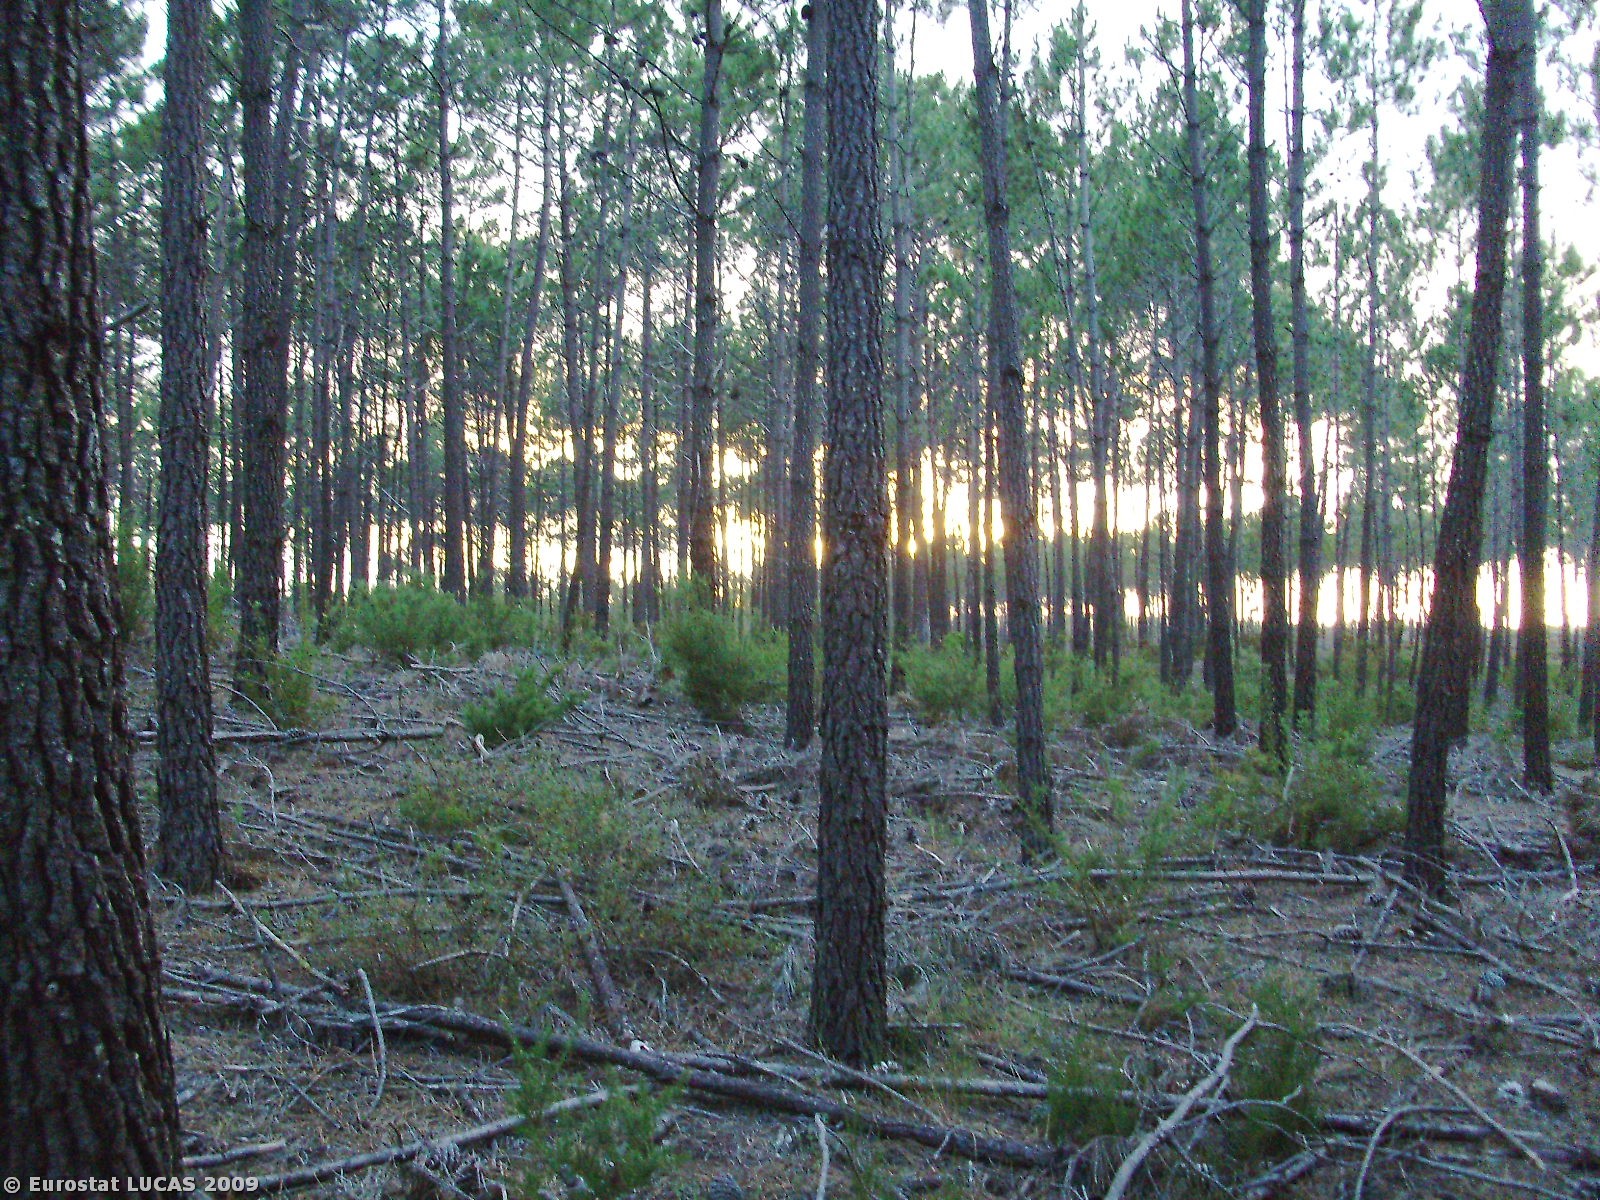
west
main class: Woodland
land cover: Coniferous woodland
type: coniferous forest of the mediterranean region
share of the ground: > 75 %
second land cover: Shrubland with sparse tree cover
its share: 10 - 25 %
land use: Forestry
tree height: > 5 m
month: July
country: PT
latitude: 39.6281
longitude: -9.0217
